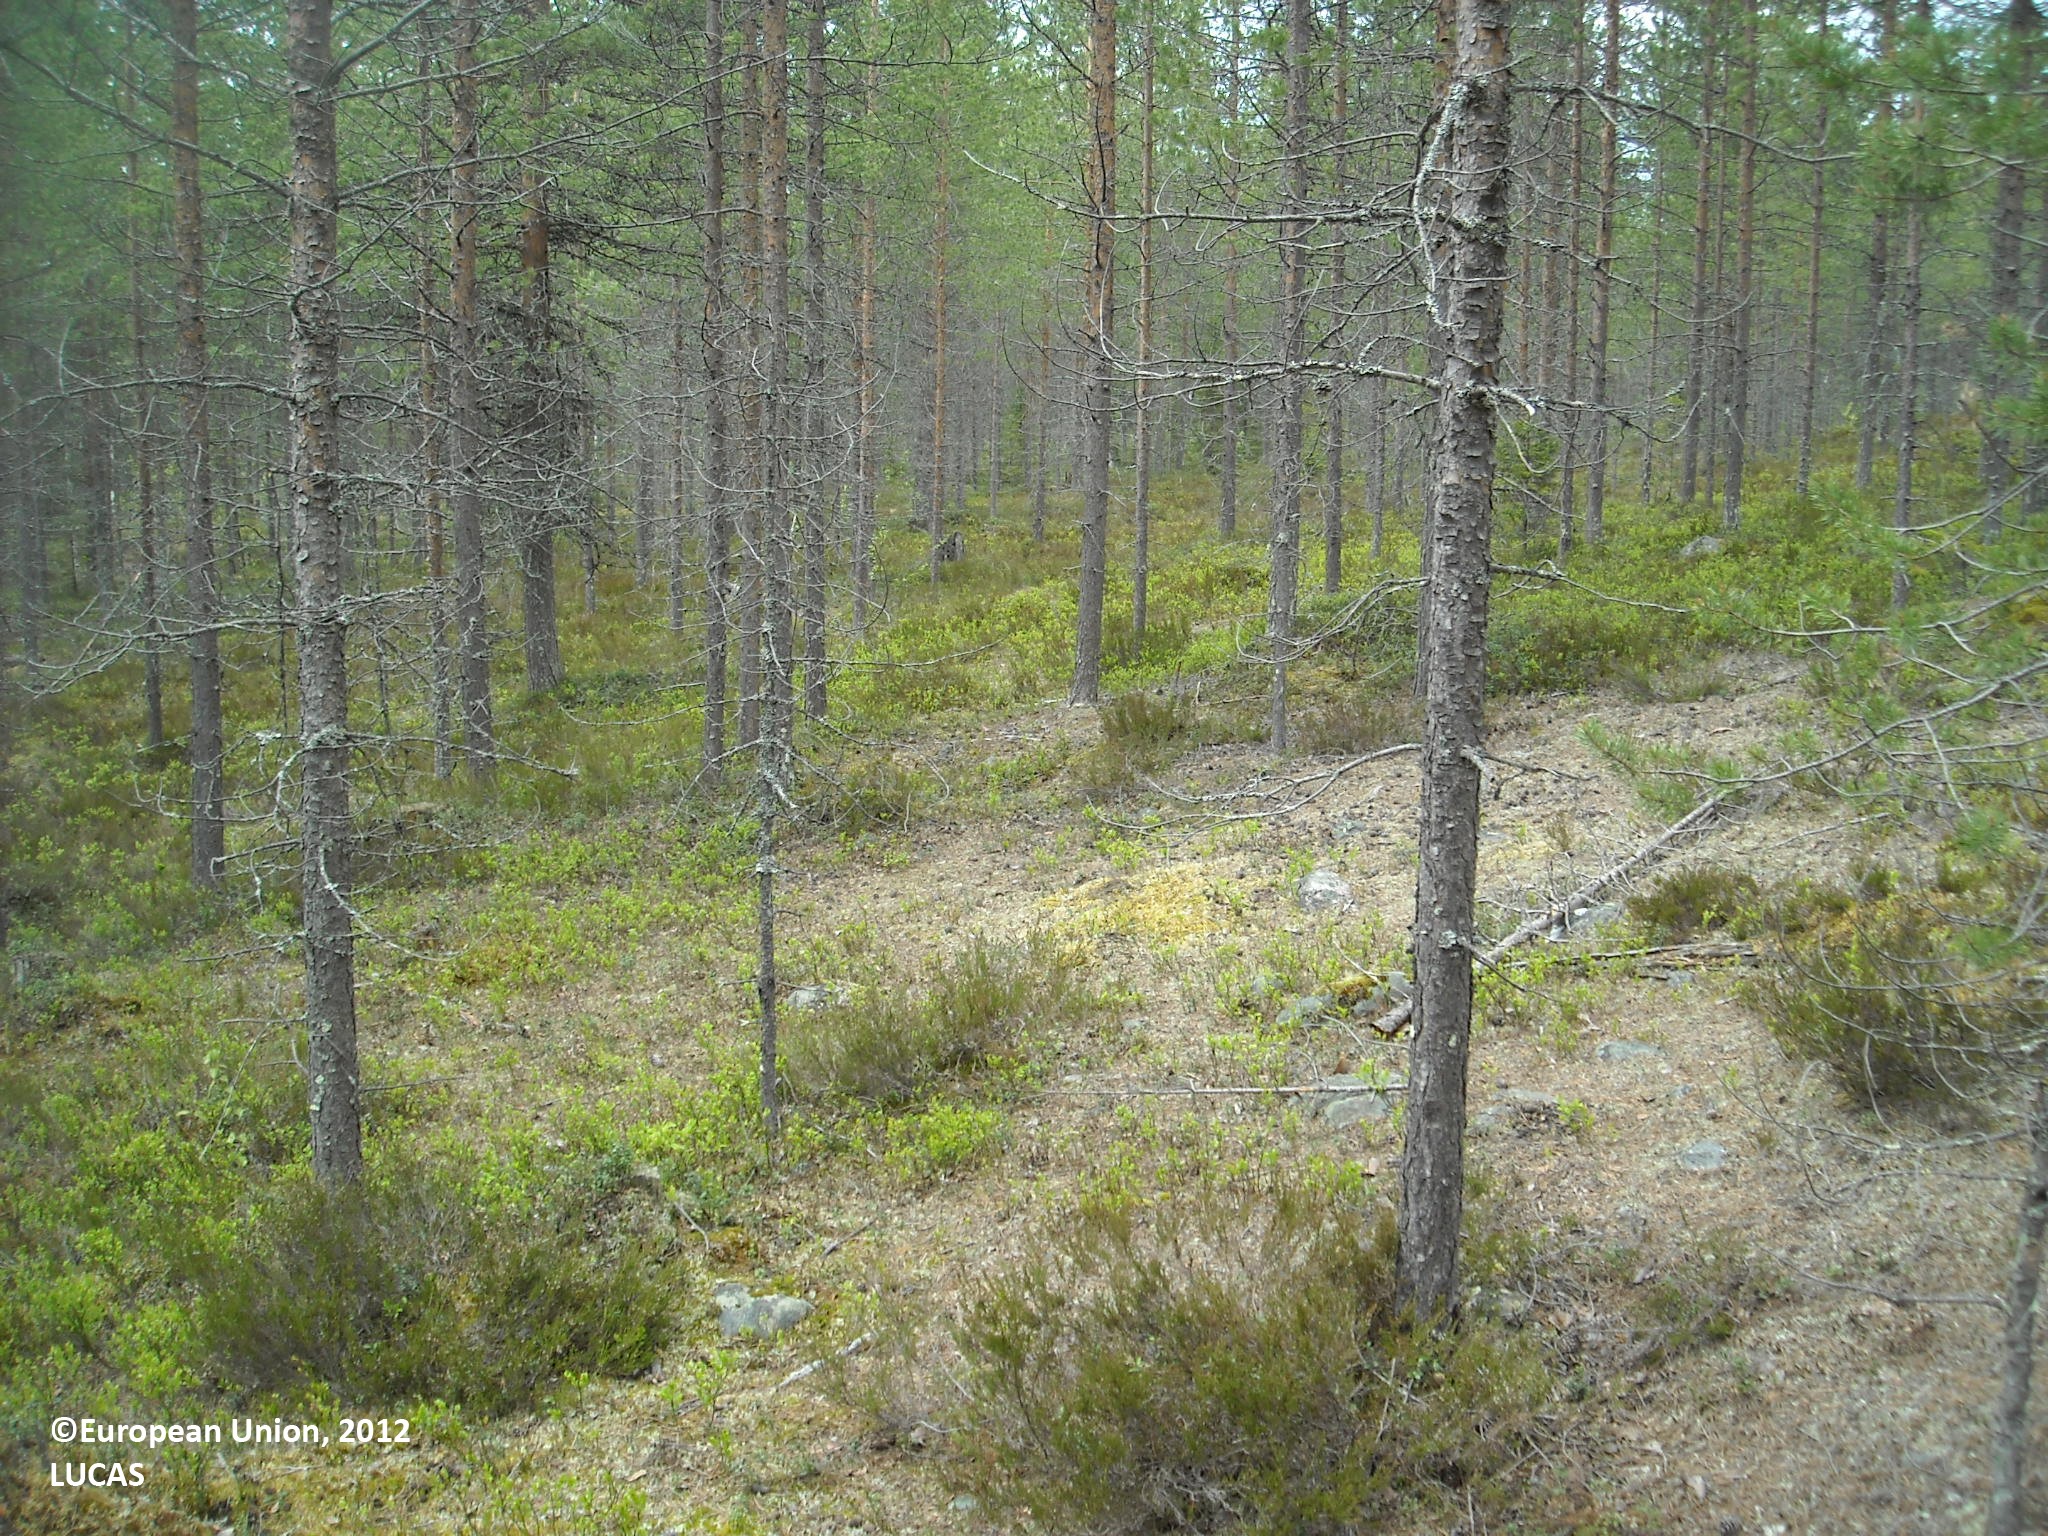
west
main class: Woodland
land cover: Pine dominated coniferous woodland
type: boreal forest
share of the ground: > 75 %
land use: Forestry
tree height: > 5 m
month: June
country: FI
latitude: 65.2343
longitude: 27.7039
